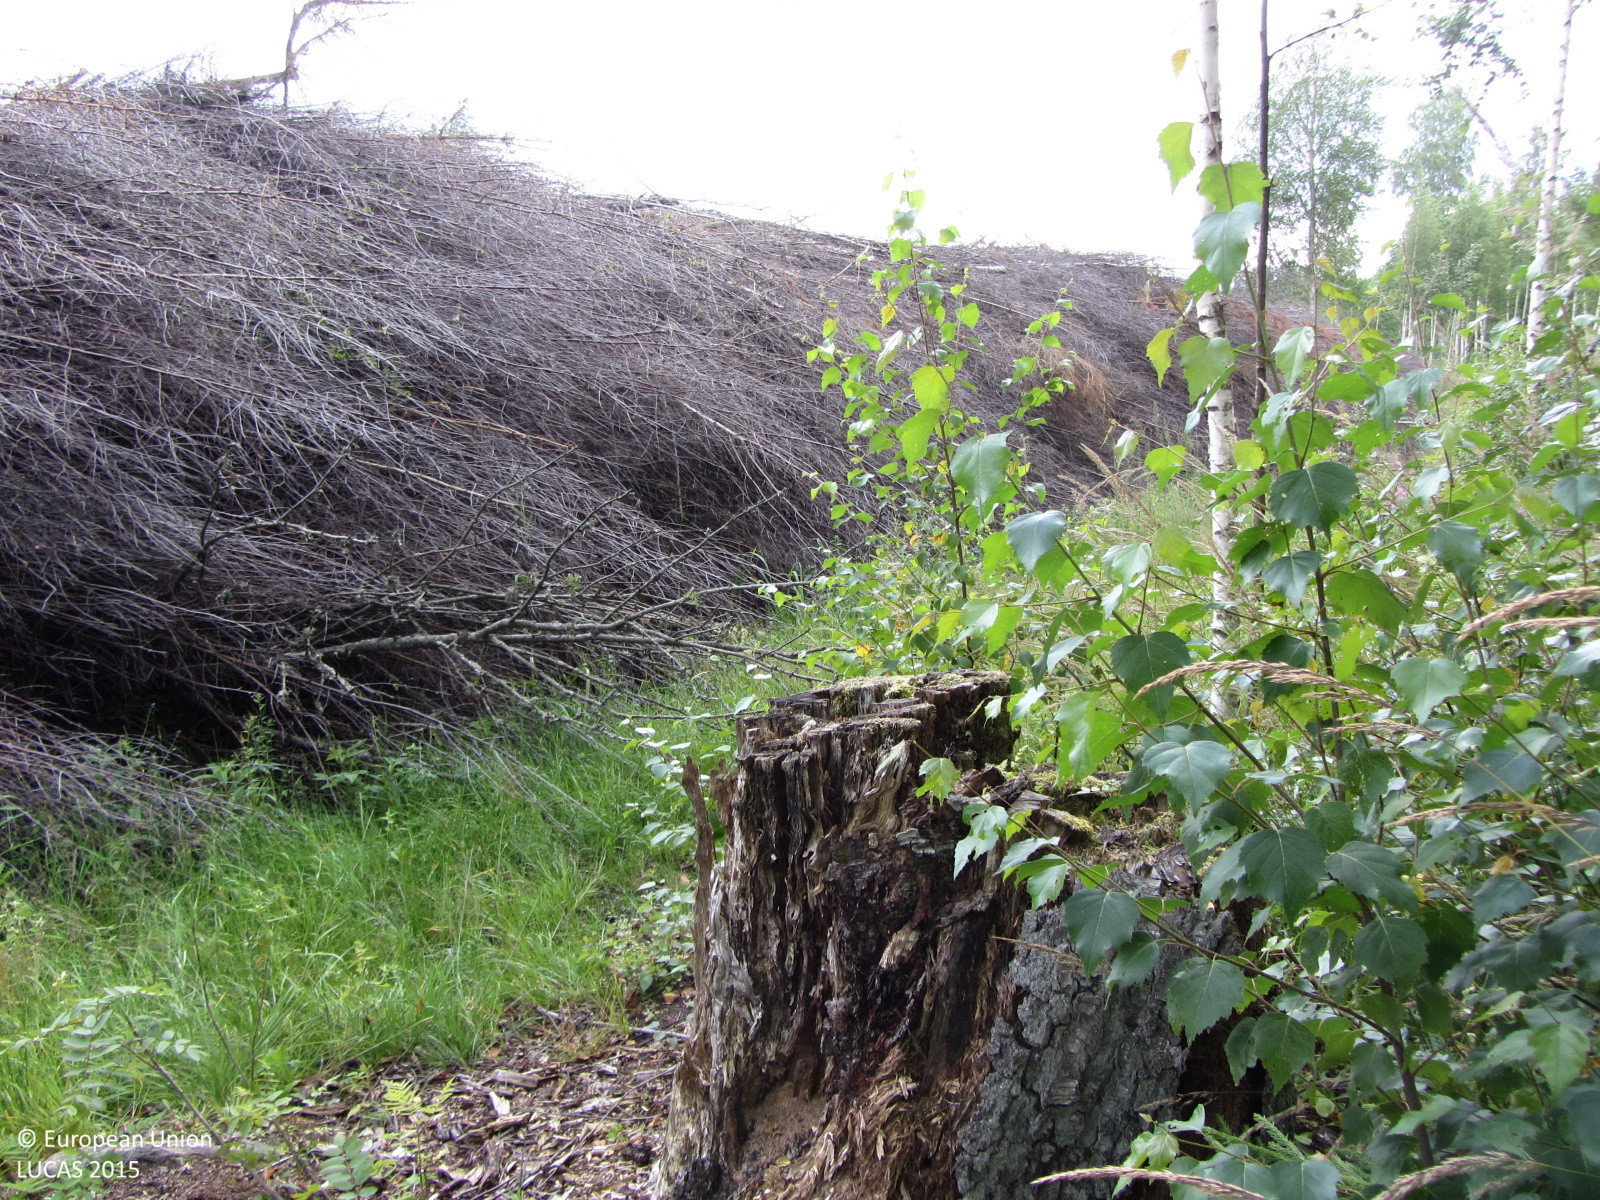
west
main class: Woodland
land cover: Broadleaved woodland
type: boreal forest
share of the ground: 25 - 50 %
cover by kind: herbaceous plants 55 %, broadleaved forest trees 45 %
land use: Forestry
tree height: > 5 m
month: July
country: FI
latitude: 60.5368
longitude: 24.9335
